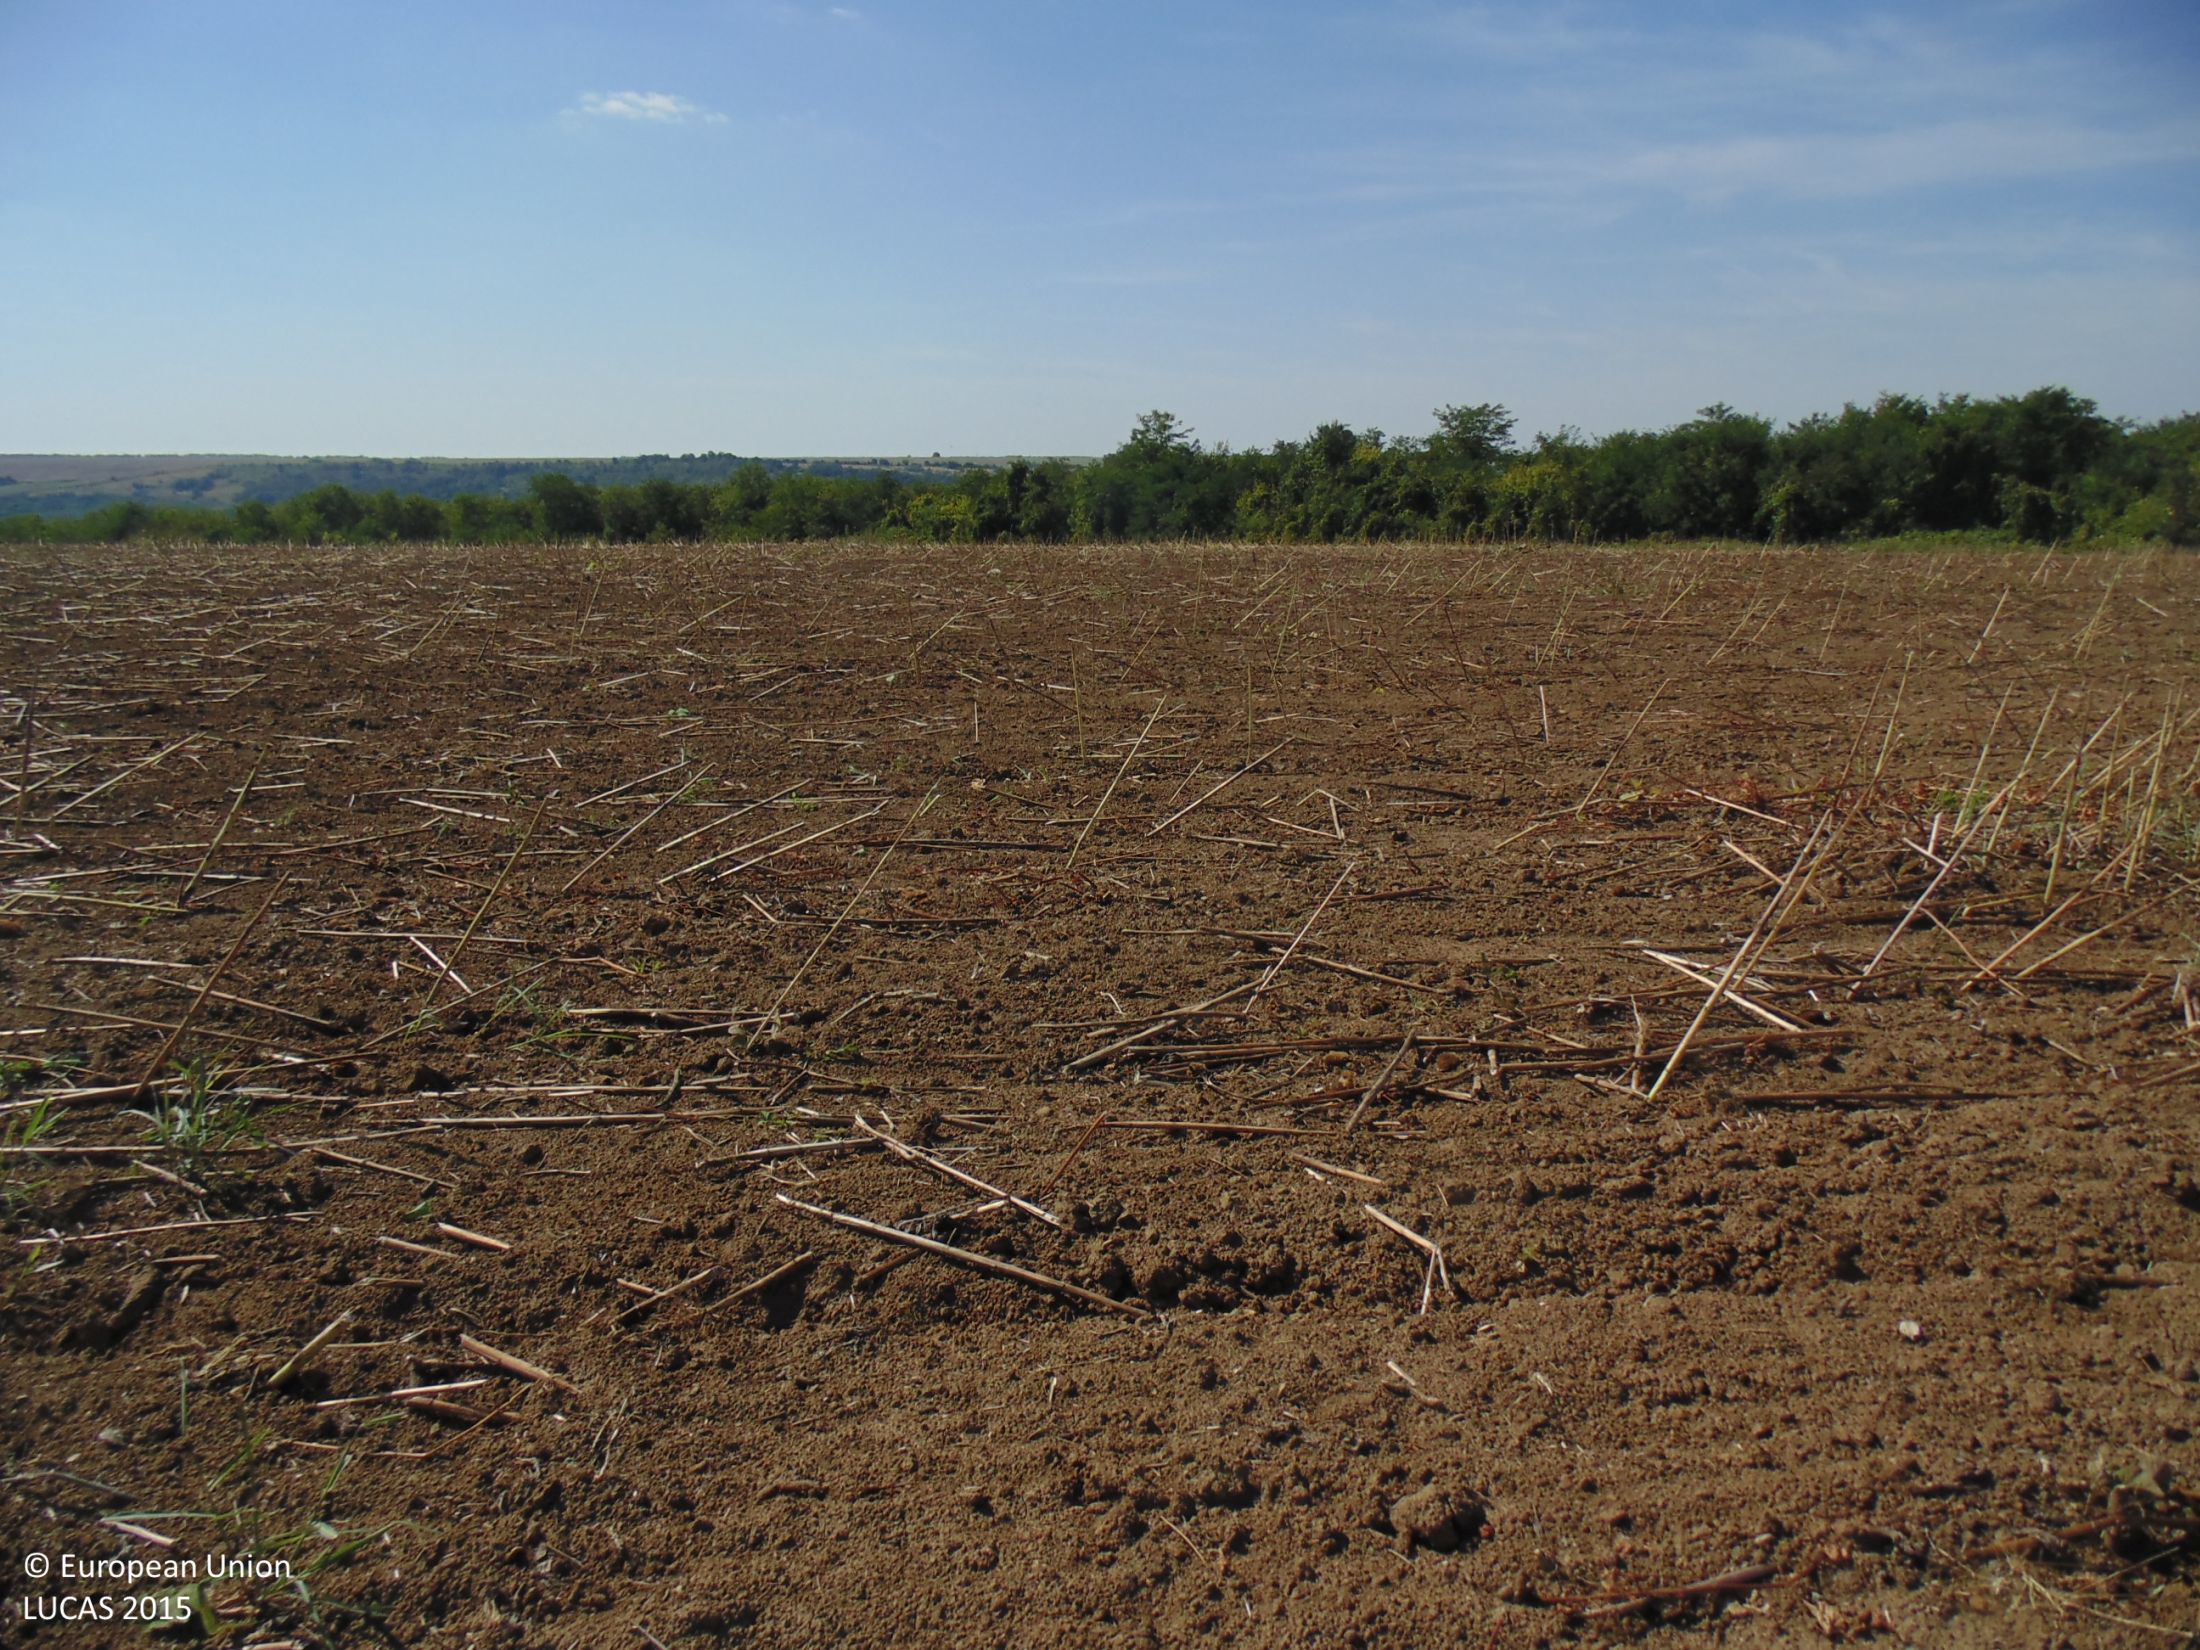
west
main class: Cropland
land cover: Sunflower
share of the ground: < 10 %
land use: Agriculture (excluding fallow land and kitchen gardens)
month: September
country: BG
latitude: 44.1068
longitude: 26.9260
